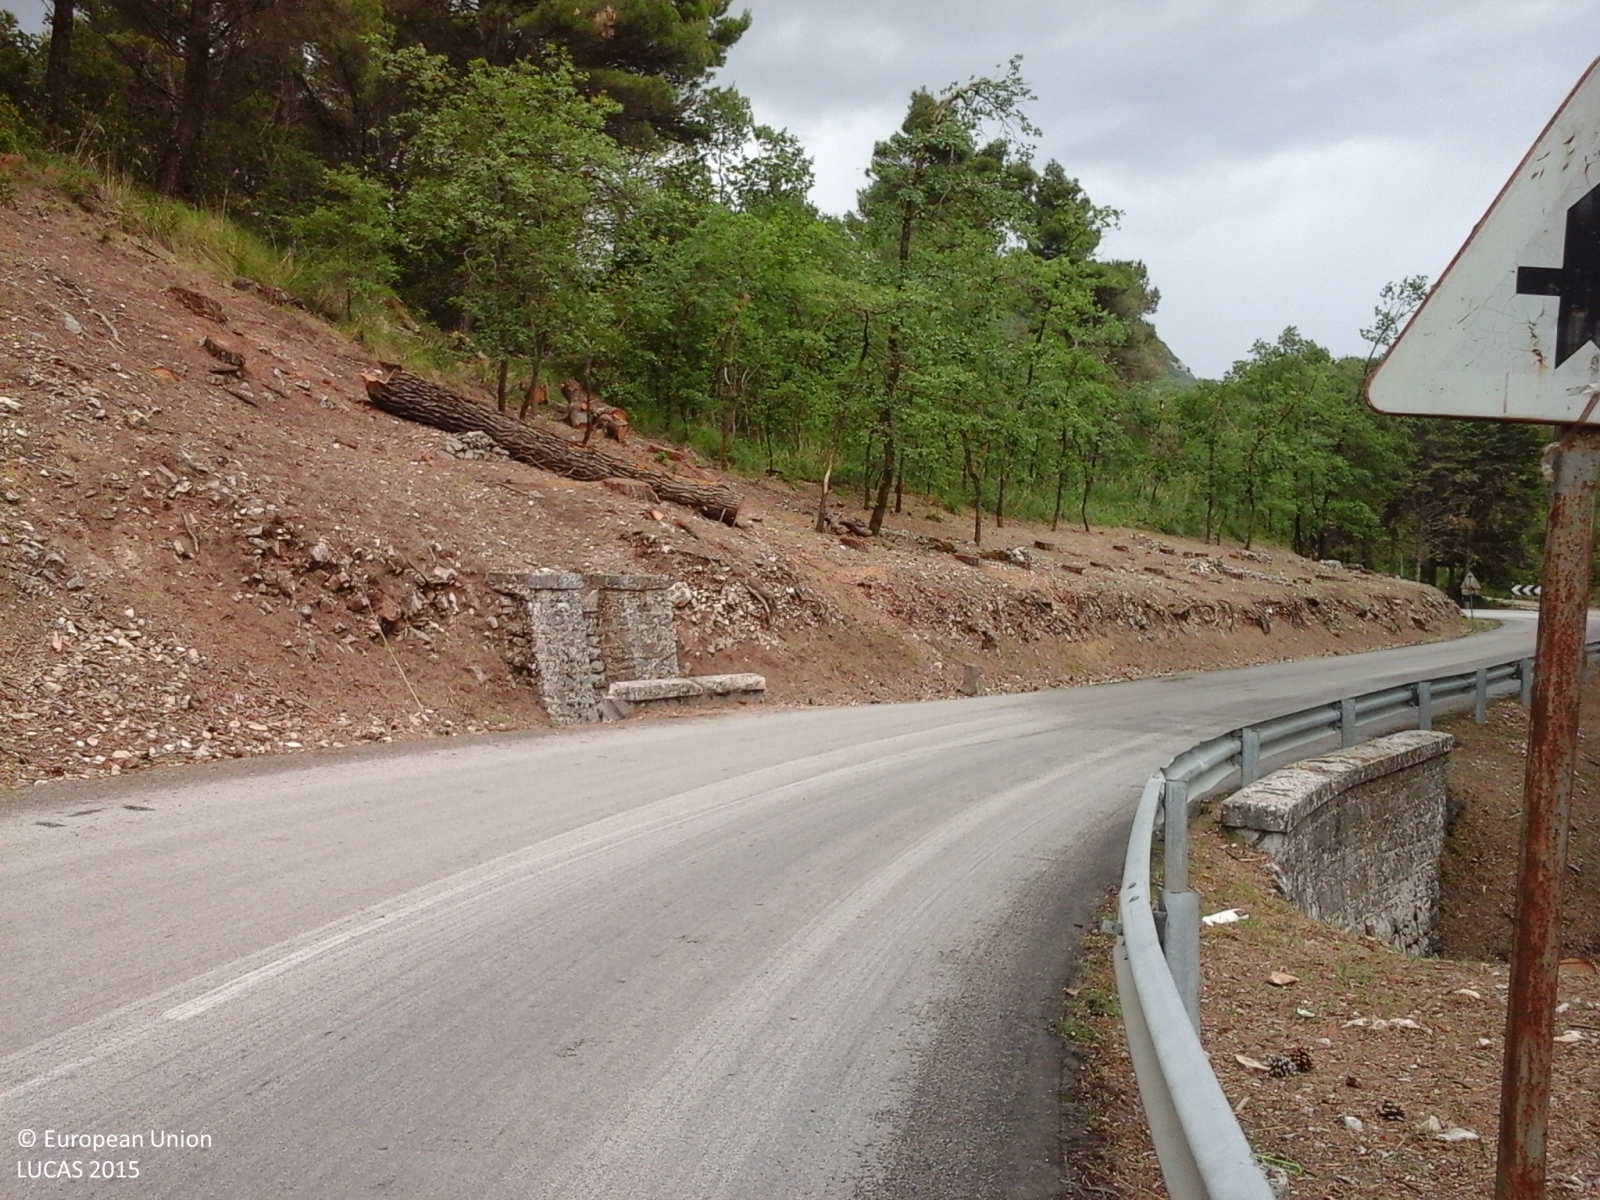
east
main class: Woodland
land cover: Pine dominated mixed woodland
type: coniferous forest of the mediterranean region
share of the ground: > 75 %
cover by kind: coniferous forest trees 50 %, broadleaved forest trees 30 %, shrubs 15 %, herbaceous plants 5 %
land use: Forestry
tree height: > 5 m
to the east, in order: Pine dominated mixed woodland
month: June
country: IT
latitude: 37.6089
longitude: 13.5418
